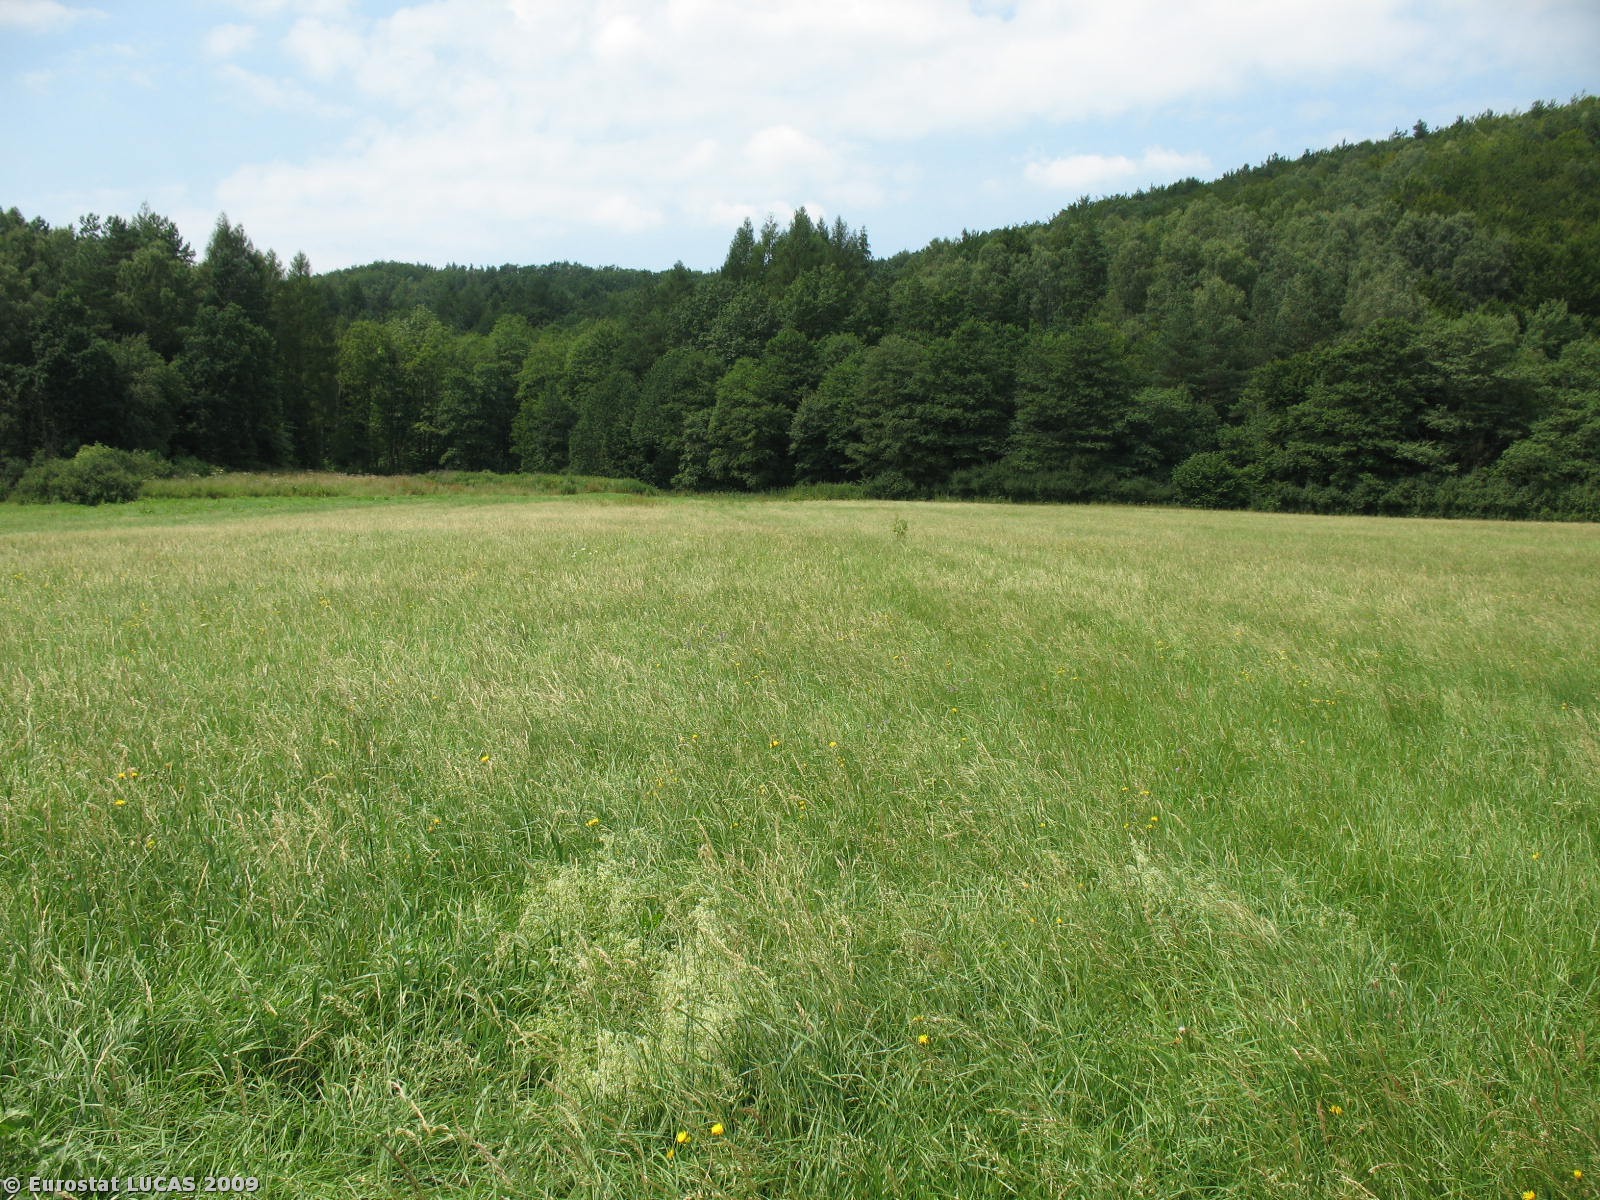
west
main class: Grassland
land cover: Grassland without tree/shrub cover
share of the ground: > 75 %
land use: Agriculture (excluding fallow land and kitchen gardens)
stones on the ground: < 10 %
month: July
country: PL
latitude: 49.5198
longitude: 21.9213
